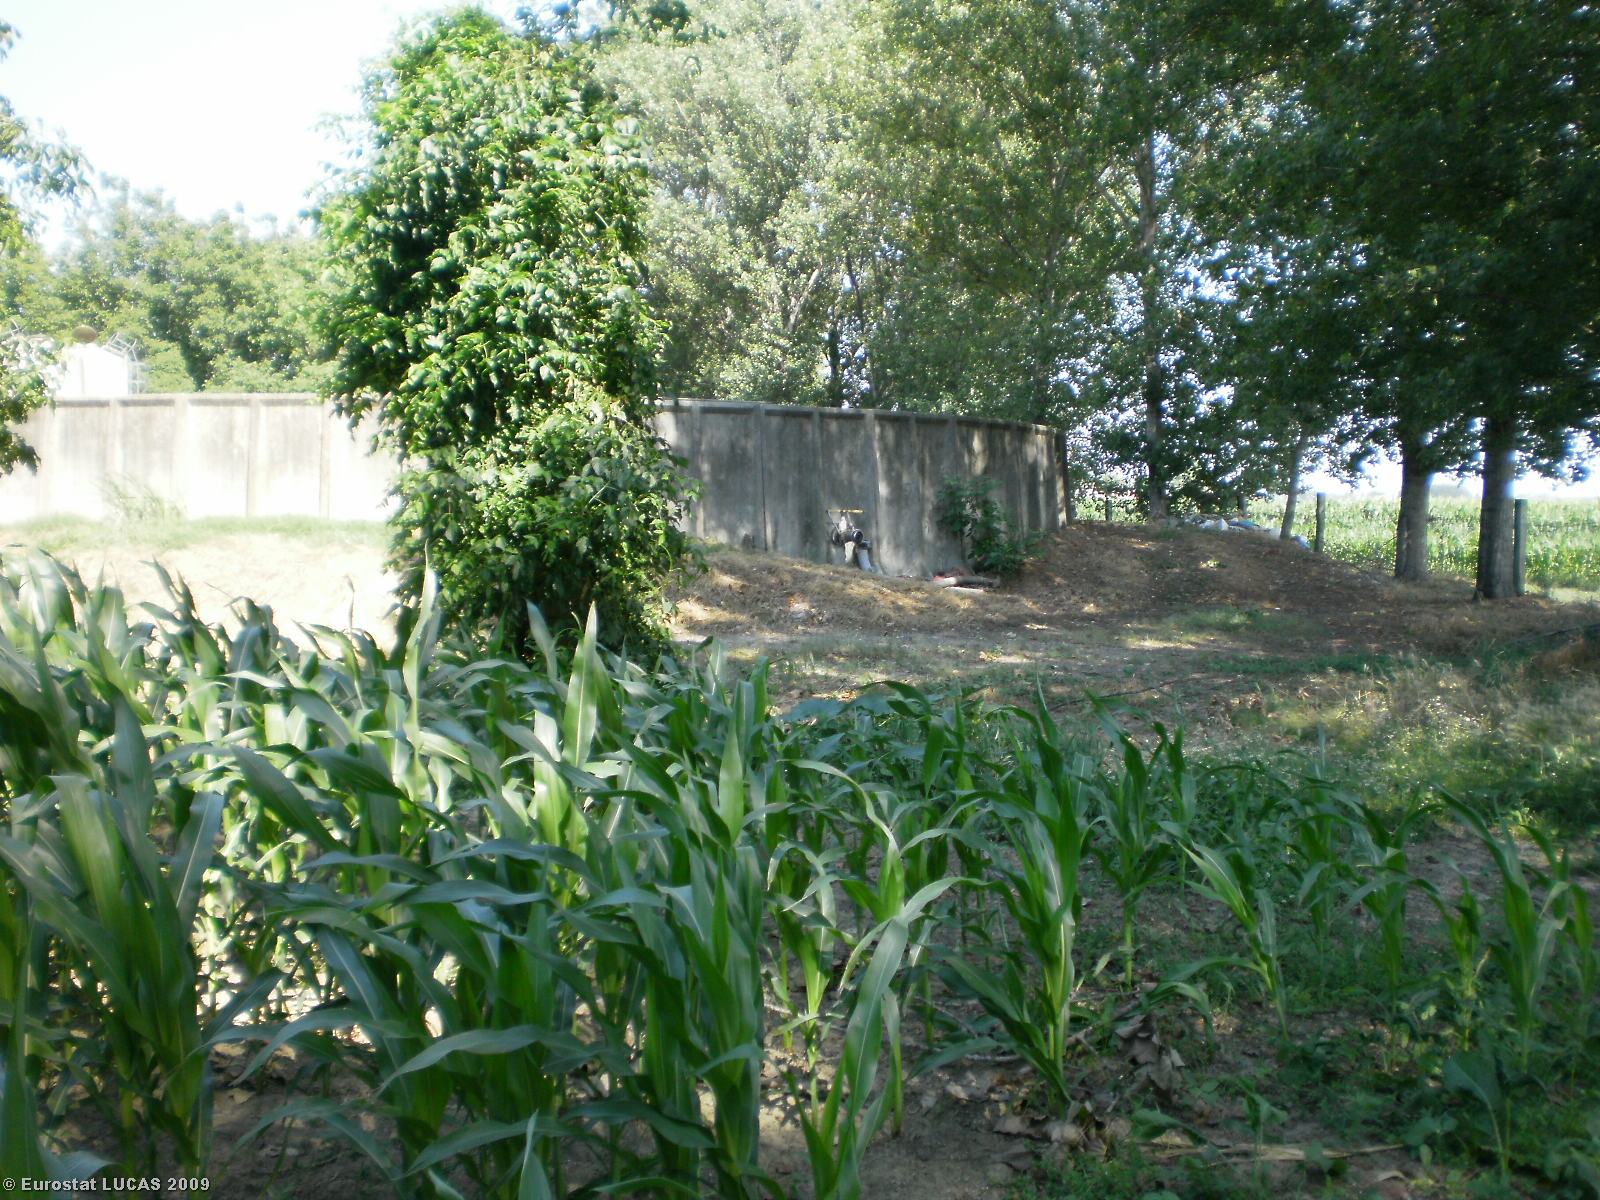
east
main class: Cropland
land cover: Maize
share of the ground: > 75 %
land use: Agriculture (excluding fallow land and kitchen gardens)
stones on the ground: < 10 %
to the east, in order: Maize; Broadleaved woodland; Artificial constructions in urban areas; Broadleaved woodland; Artificial constructions in urban areas; Sugar beet; Grass margins; Ditches and canals; Grass margins; Maize; Electric lines; Maize
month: June
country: IT
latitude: 45.0172
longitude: 10.3166
